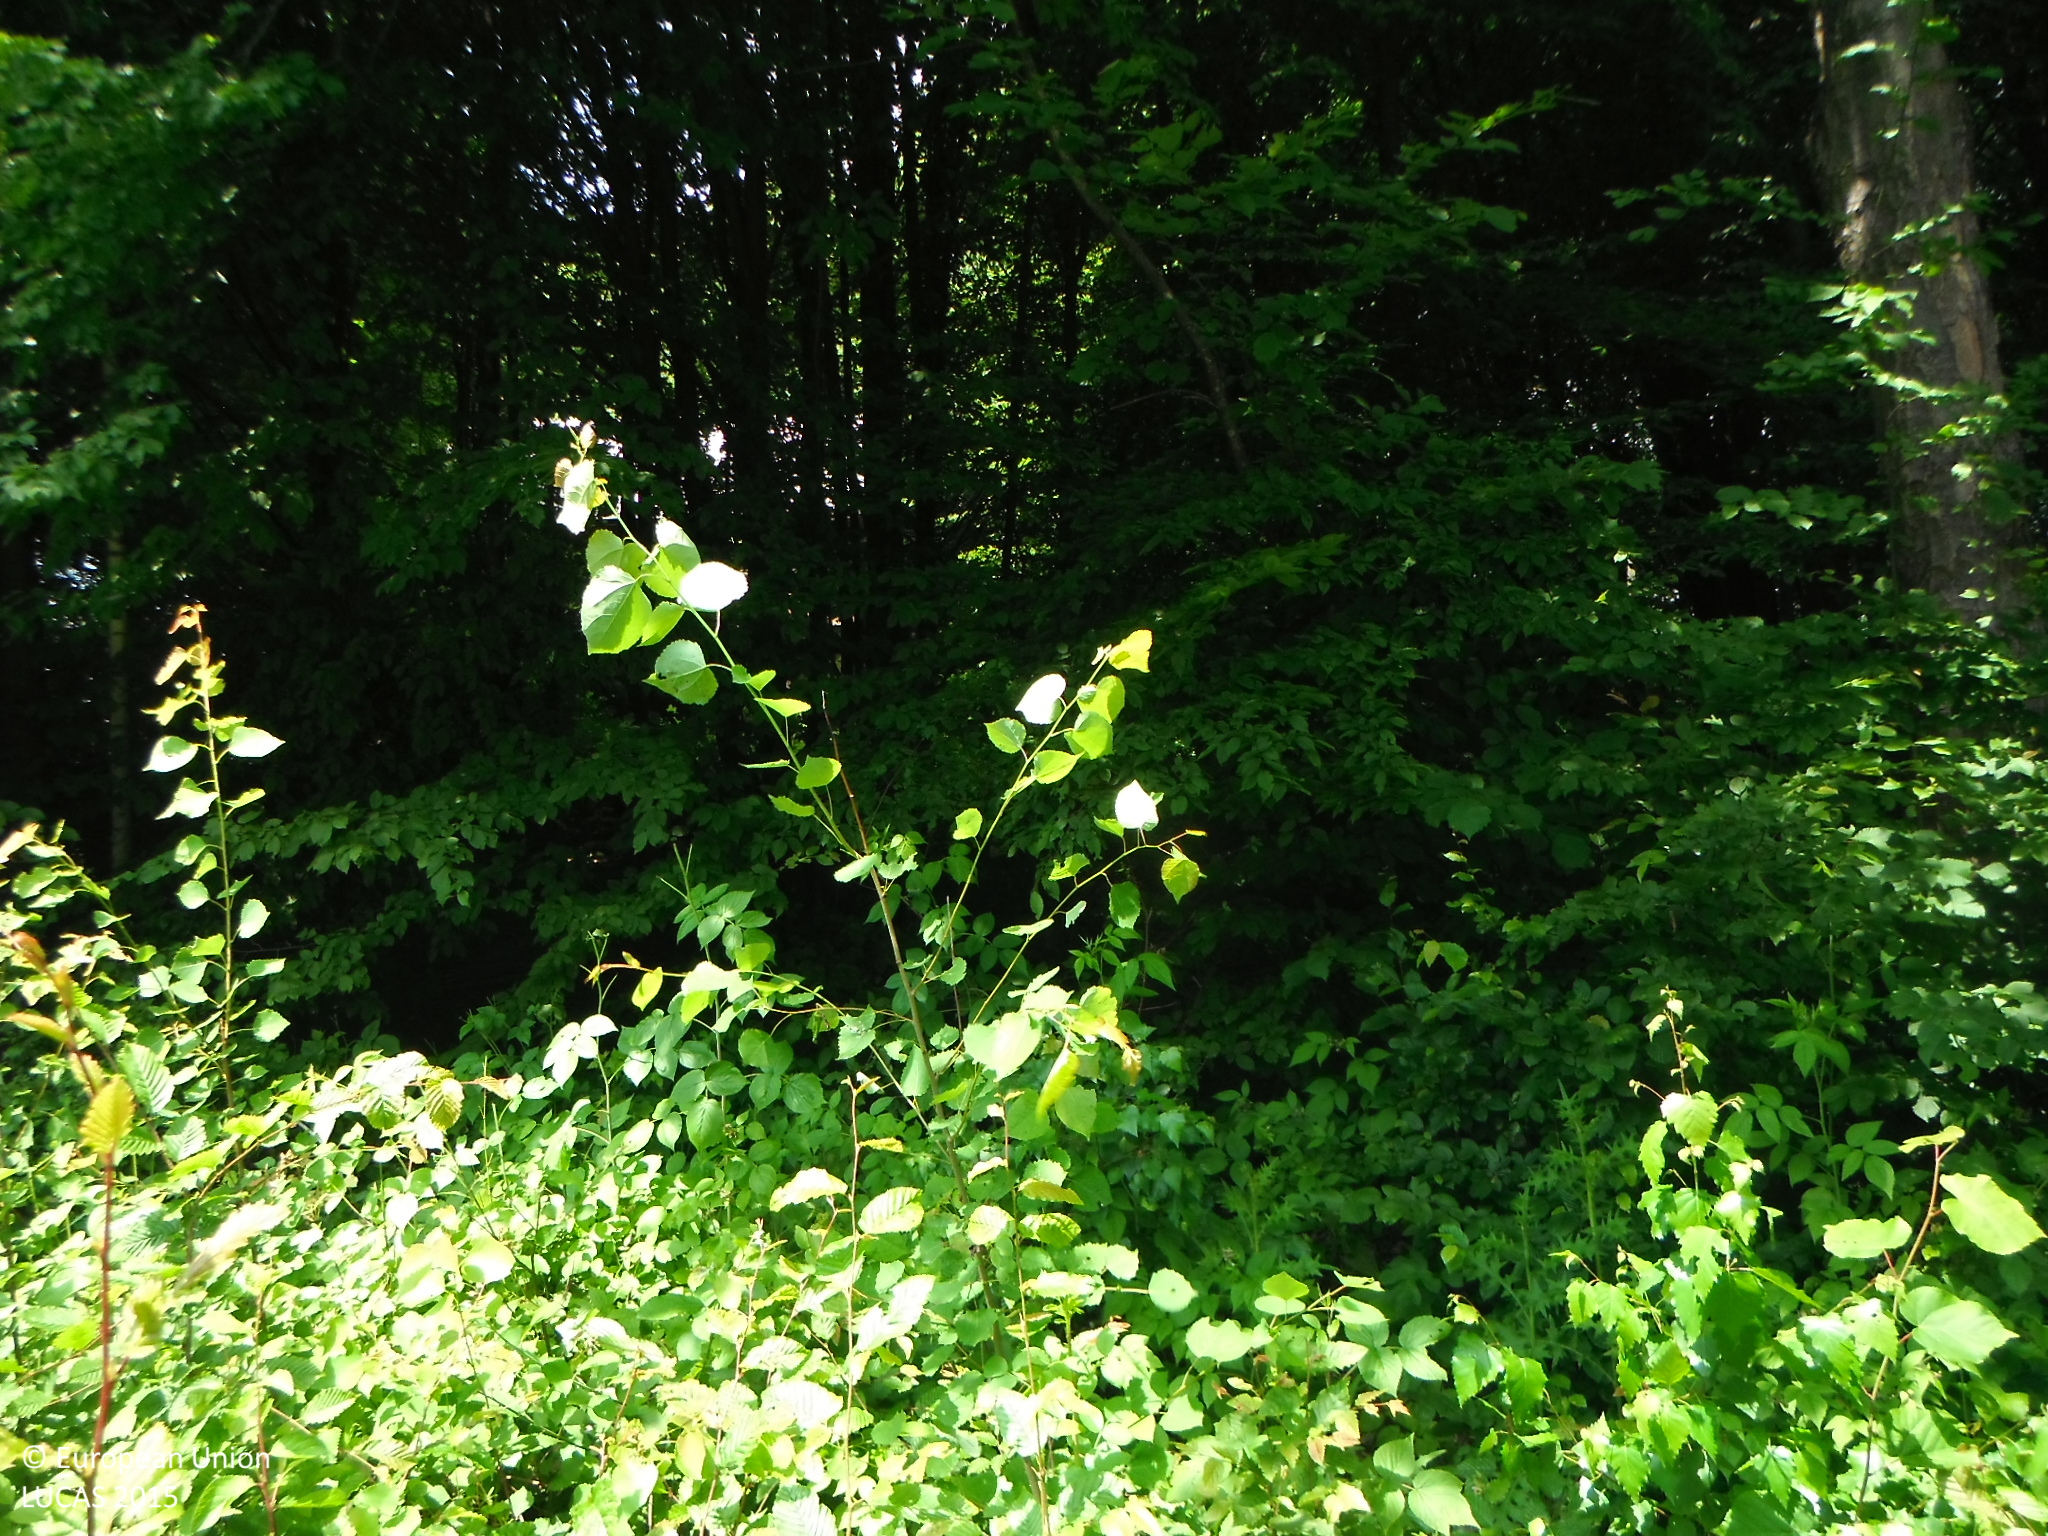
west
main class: Shrubland
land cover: Shrubland with sparse tree cover
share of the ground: > 75 %
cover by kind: shrubs 95 %, broadleaved forest trees 5 %
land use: Semi-natural and natural areas not in use
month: June
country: SK
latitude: 48.8449
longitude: 21.0662
